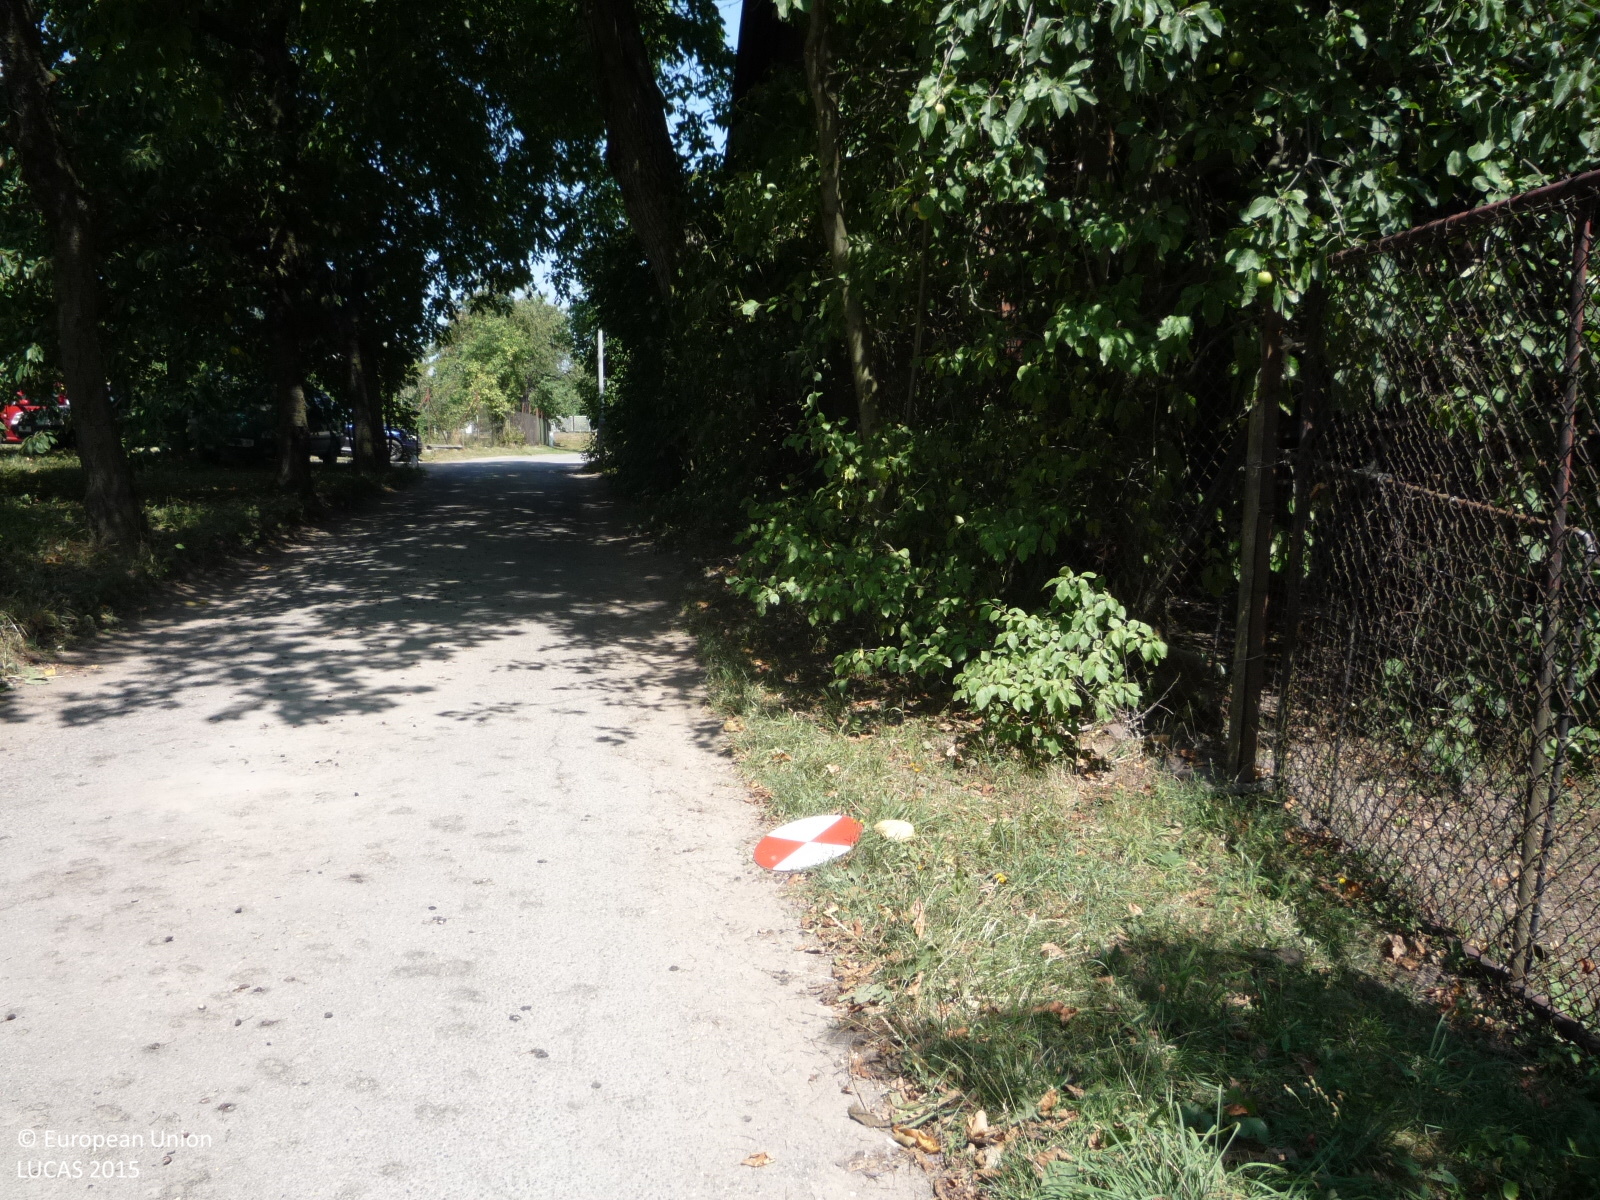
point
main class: Cropland
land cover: Apple fruit
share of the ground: > 75 %
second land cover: Grassland without tree/shrub cover
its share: 10 - 25 %
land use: Kitchen garden
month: August
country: CZ
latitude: 50.5683
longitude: 15.2415
